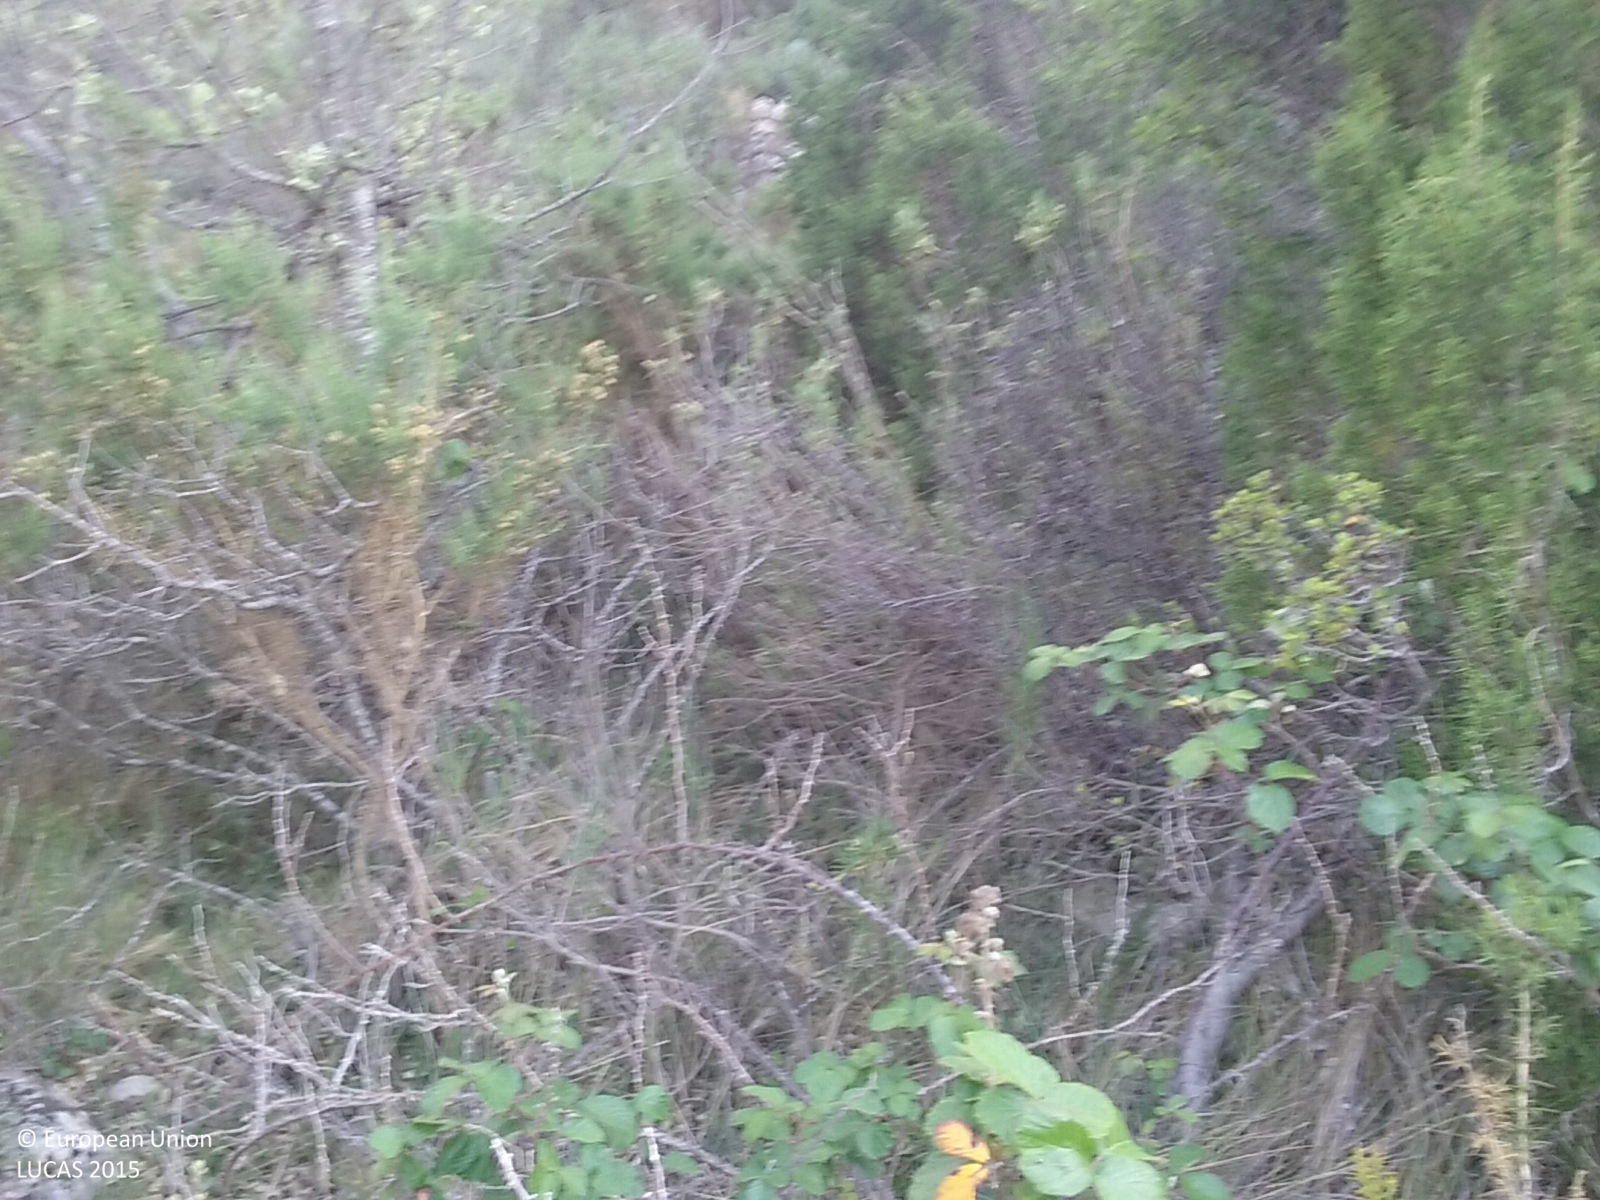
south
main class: Woodland
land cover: Broadleaved woodland
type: broadleaved evergreen forest
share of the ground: 50 - 75 %
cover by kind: broadleaved forest trees 80 %, shrubs 15 %
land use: Semi-natural and natural areas not in use
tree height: > 5 m
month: May
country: ES
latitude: 40.3825
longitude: -0.0999
